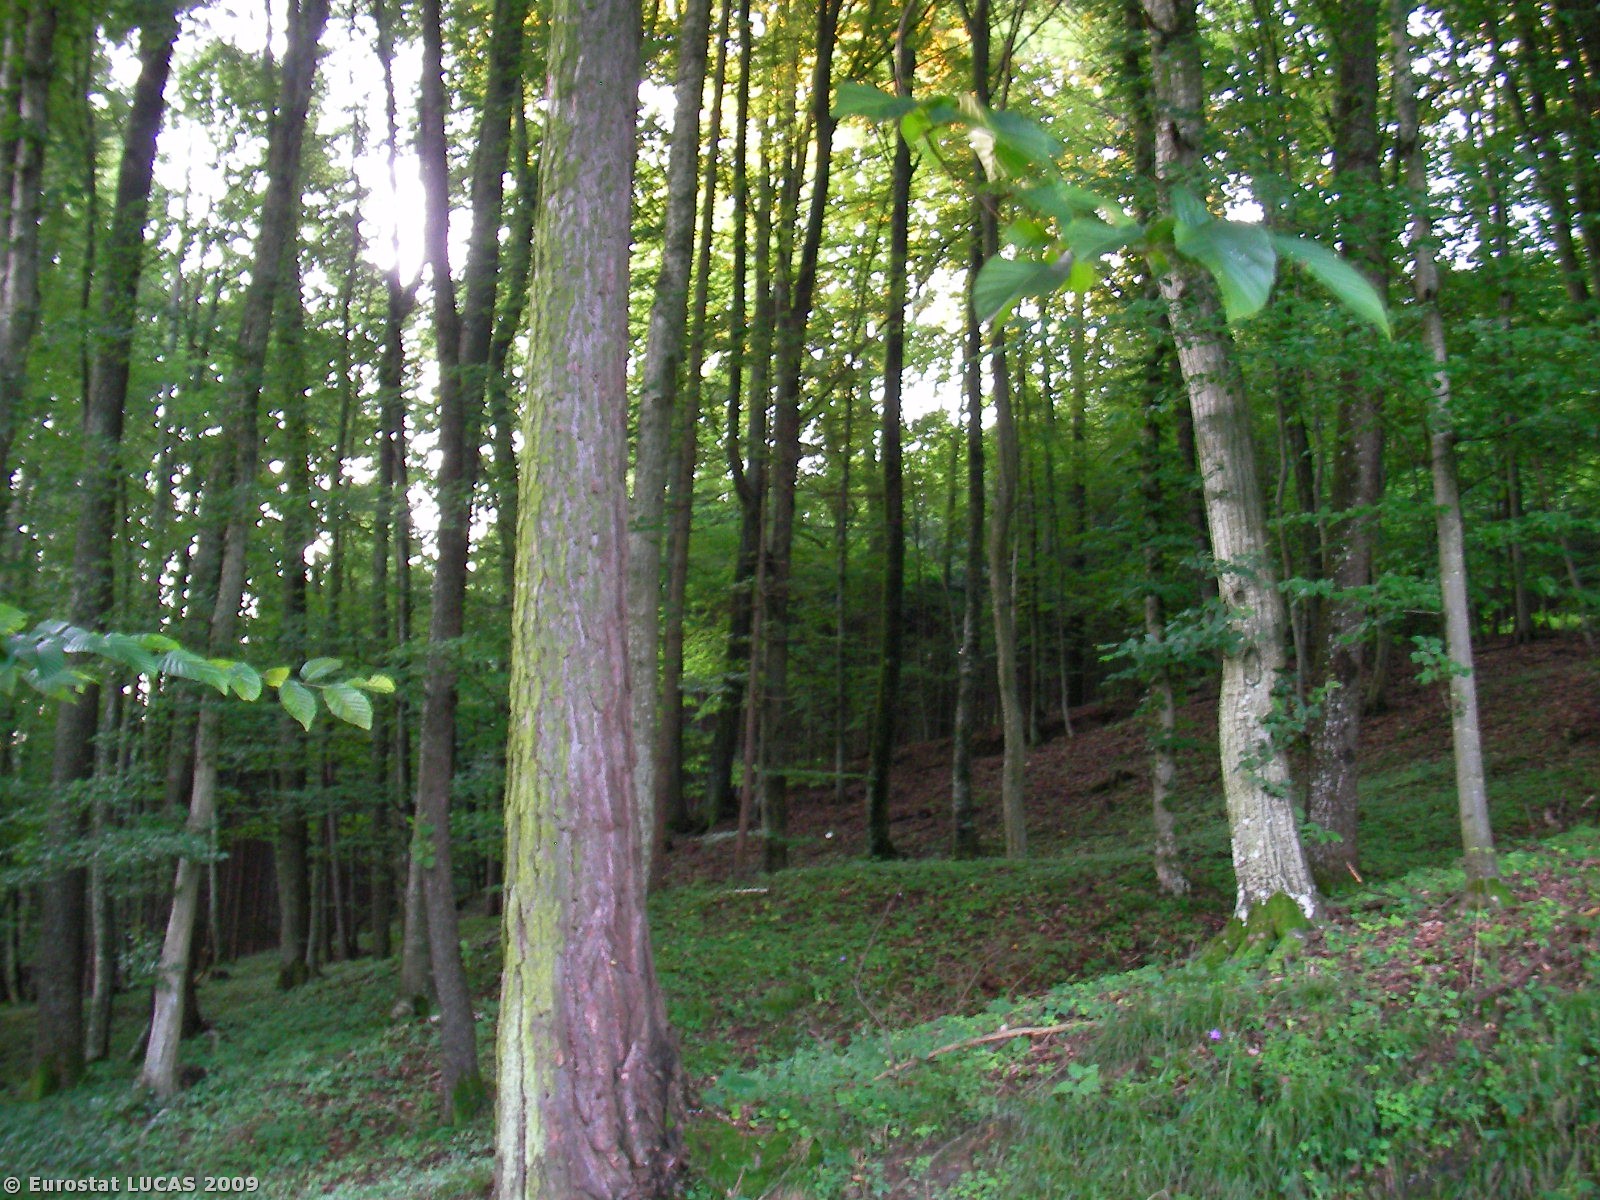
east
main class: Woodland
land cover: Broadleaved woodland
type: beech forest
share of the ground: > 75 %
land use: Forestry
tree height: > 5 m
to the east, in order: Broadleaved woodland; Tracks; Broadleaved woodland; Tracks; Broadleaved woodland; Coniferous woodland; Broadleaved woodland; Rivers and streams; Mixed woodland; Tracks; Broadleaved woodland
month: July
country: AT
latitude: 46.9745
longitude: 15.7183
